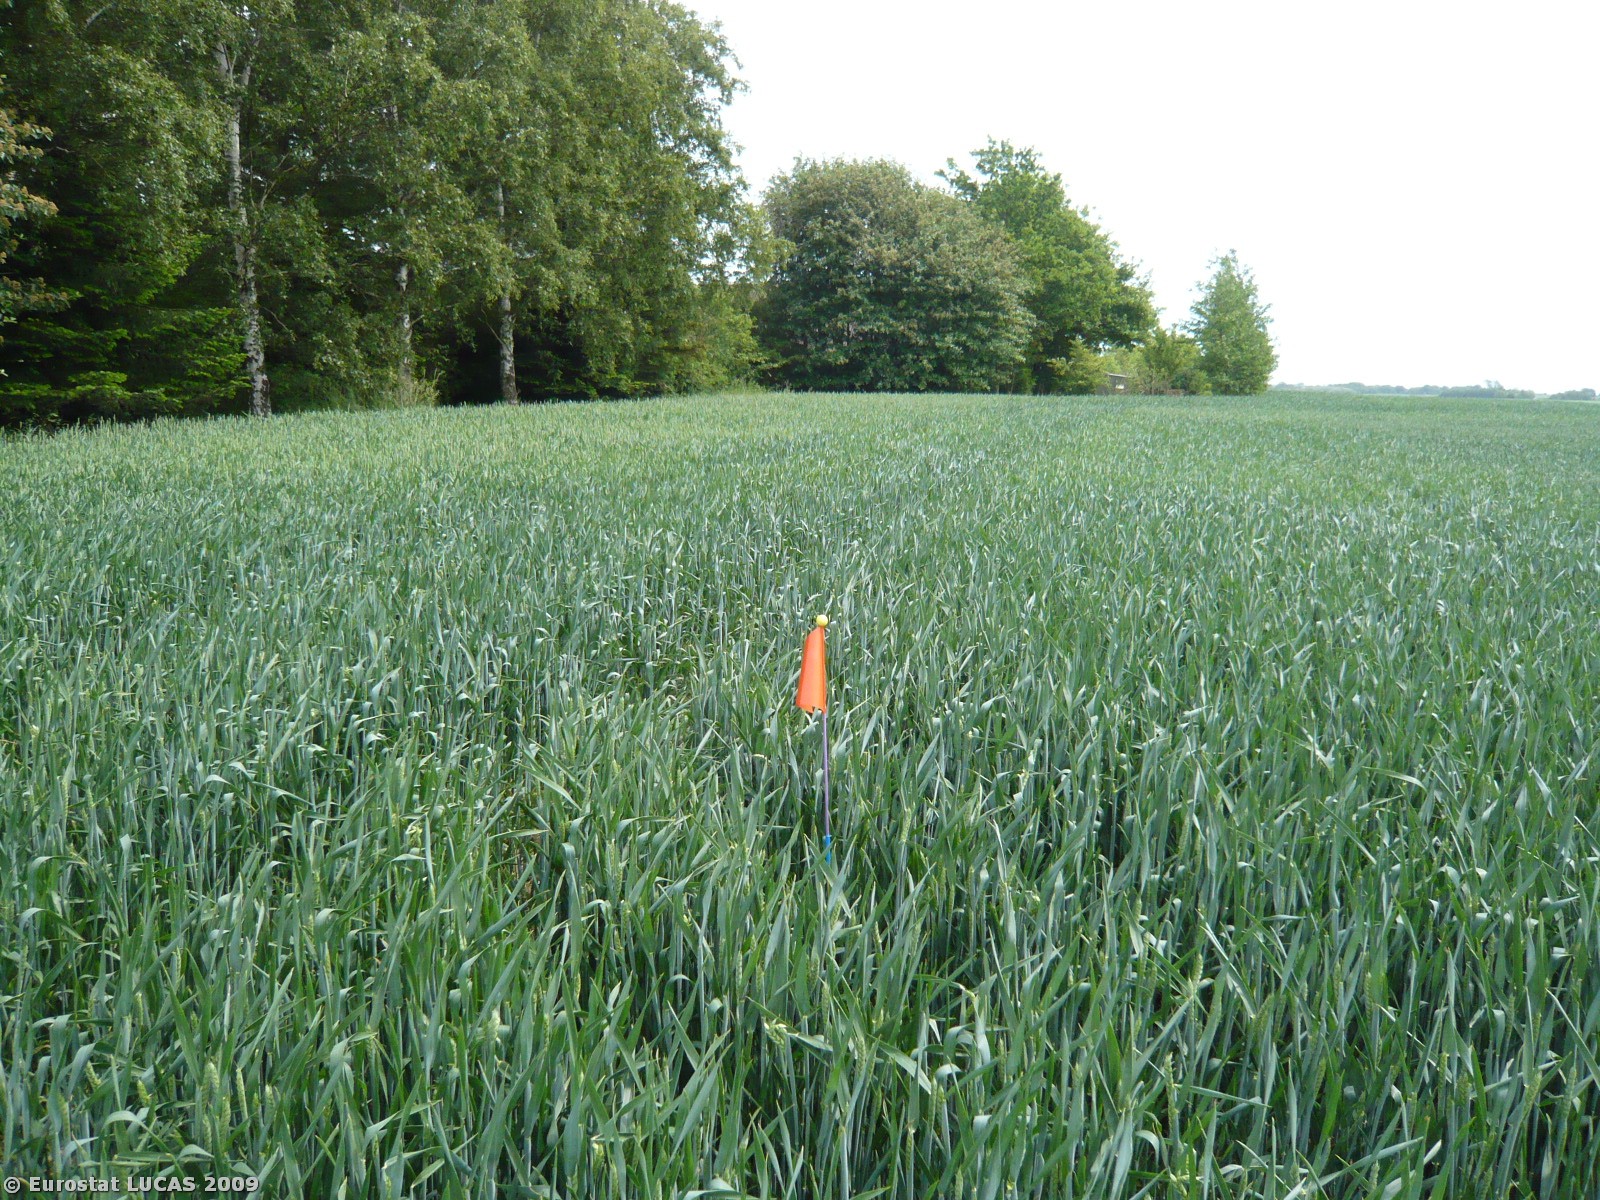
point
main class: Cropland
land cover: Common wheat
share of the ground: > 75 %
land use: Agriculture (excluding fallow land and kitchen gardens)
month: June
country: DK
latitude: 55.2816
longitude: 11.3686
